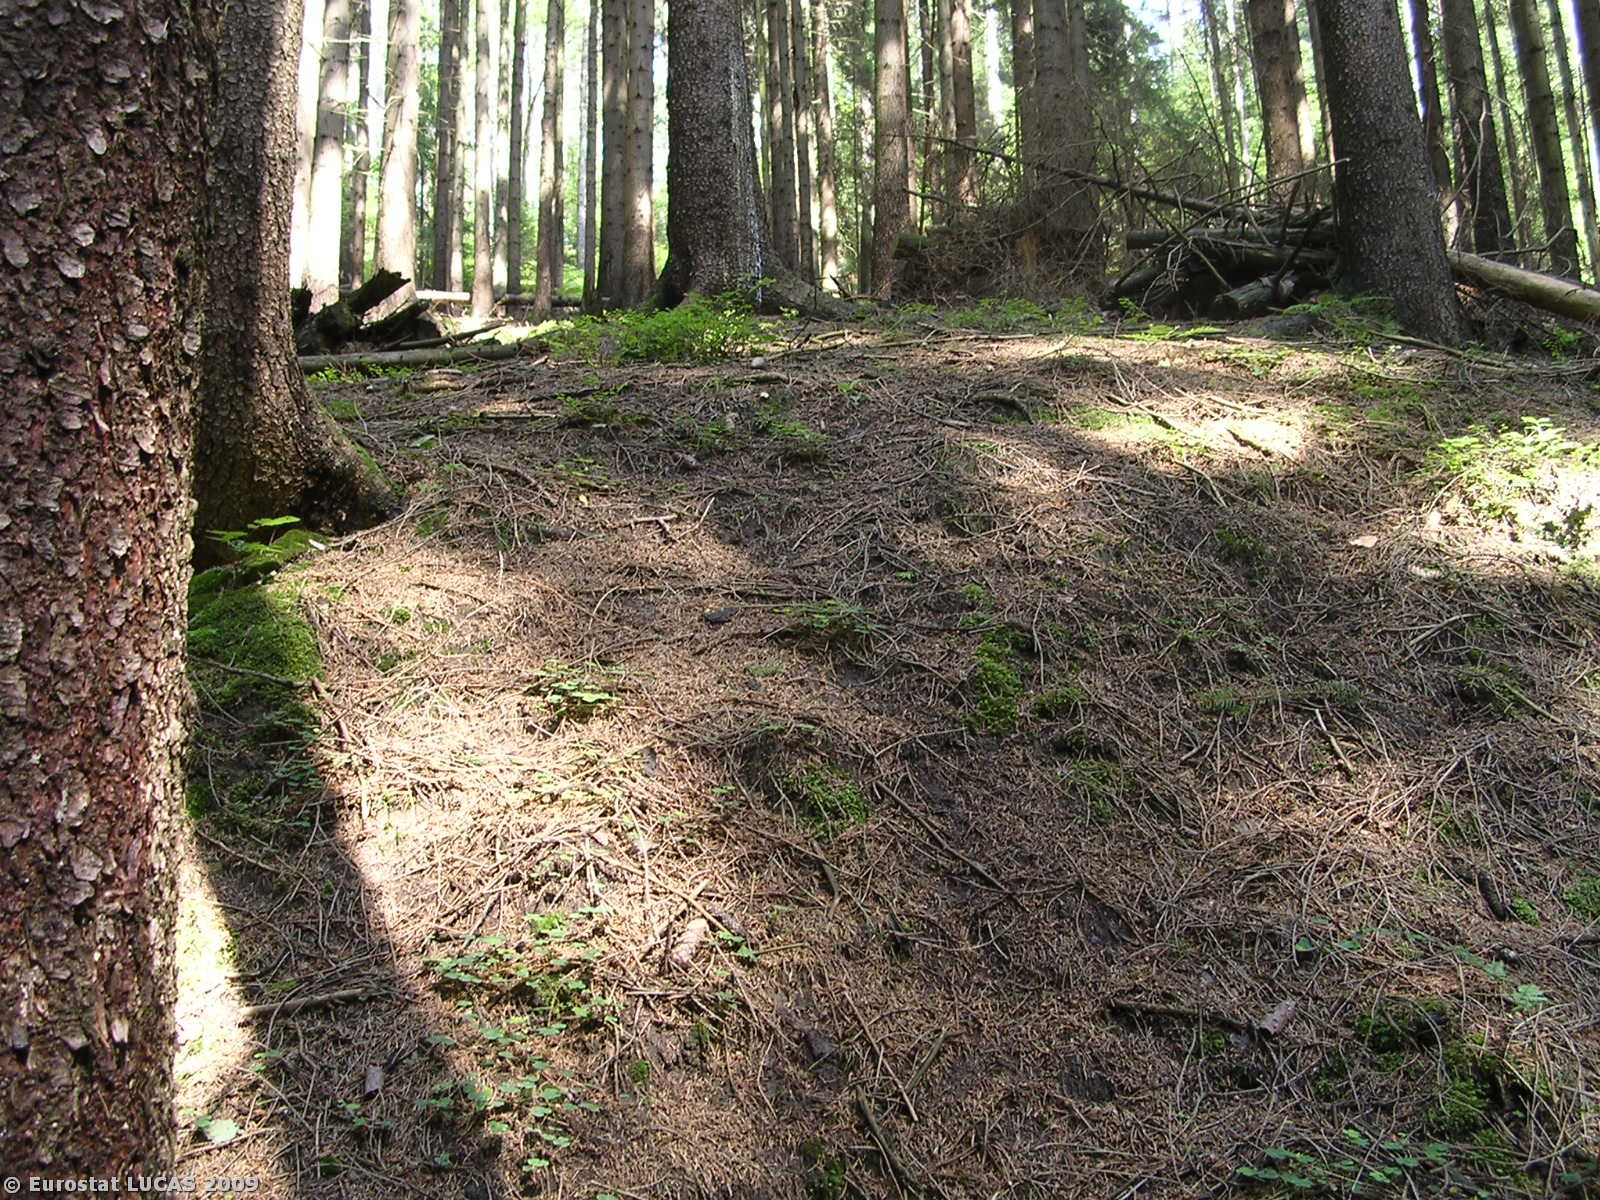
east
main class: Woodland
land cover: Coniferous woodland
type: hemiboreal forest and nemoral coniferous forest and mixed broadleaved-coniferous forest
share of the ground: > 75 %
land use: Forestry
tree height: > 5 m
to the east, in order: Coniferous woodland; Tracks; Coniferous woodland; Bare land; Fences; Bare land
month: July
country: CZ
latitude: 50.6705
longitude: 14.9693
